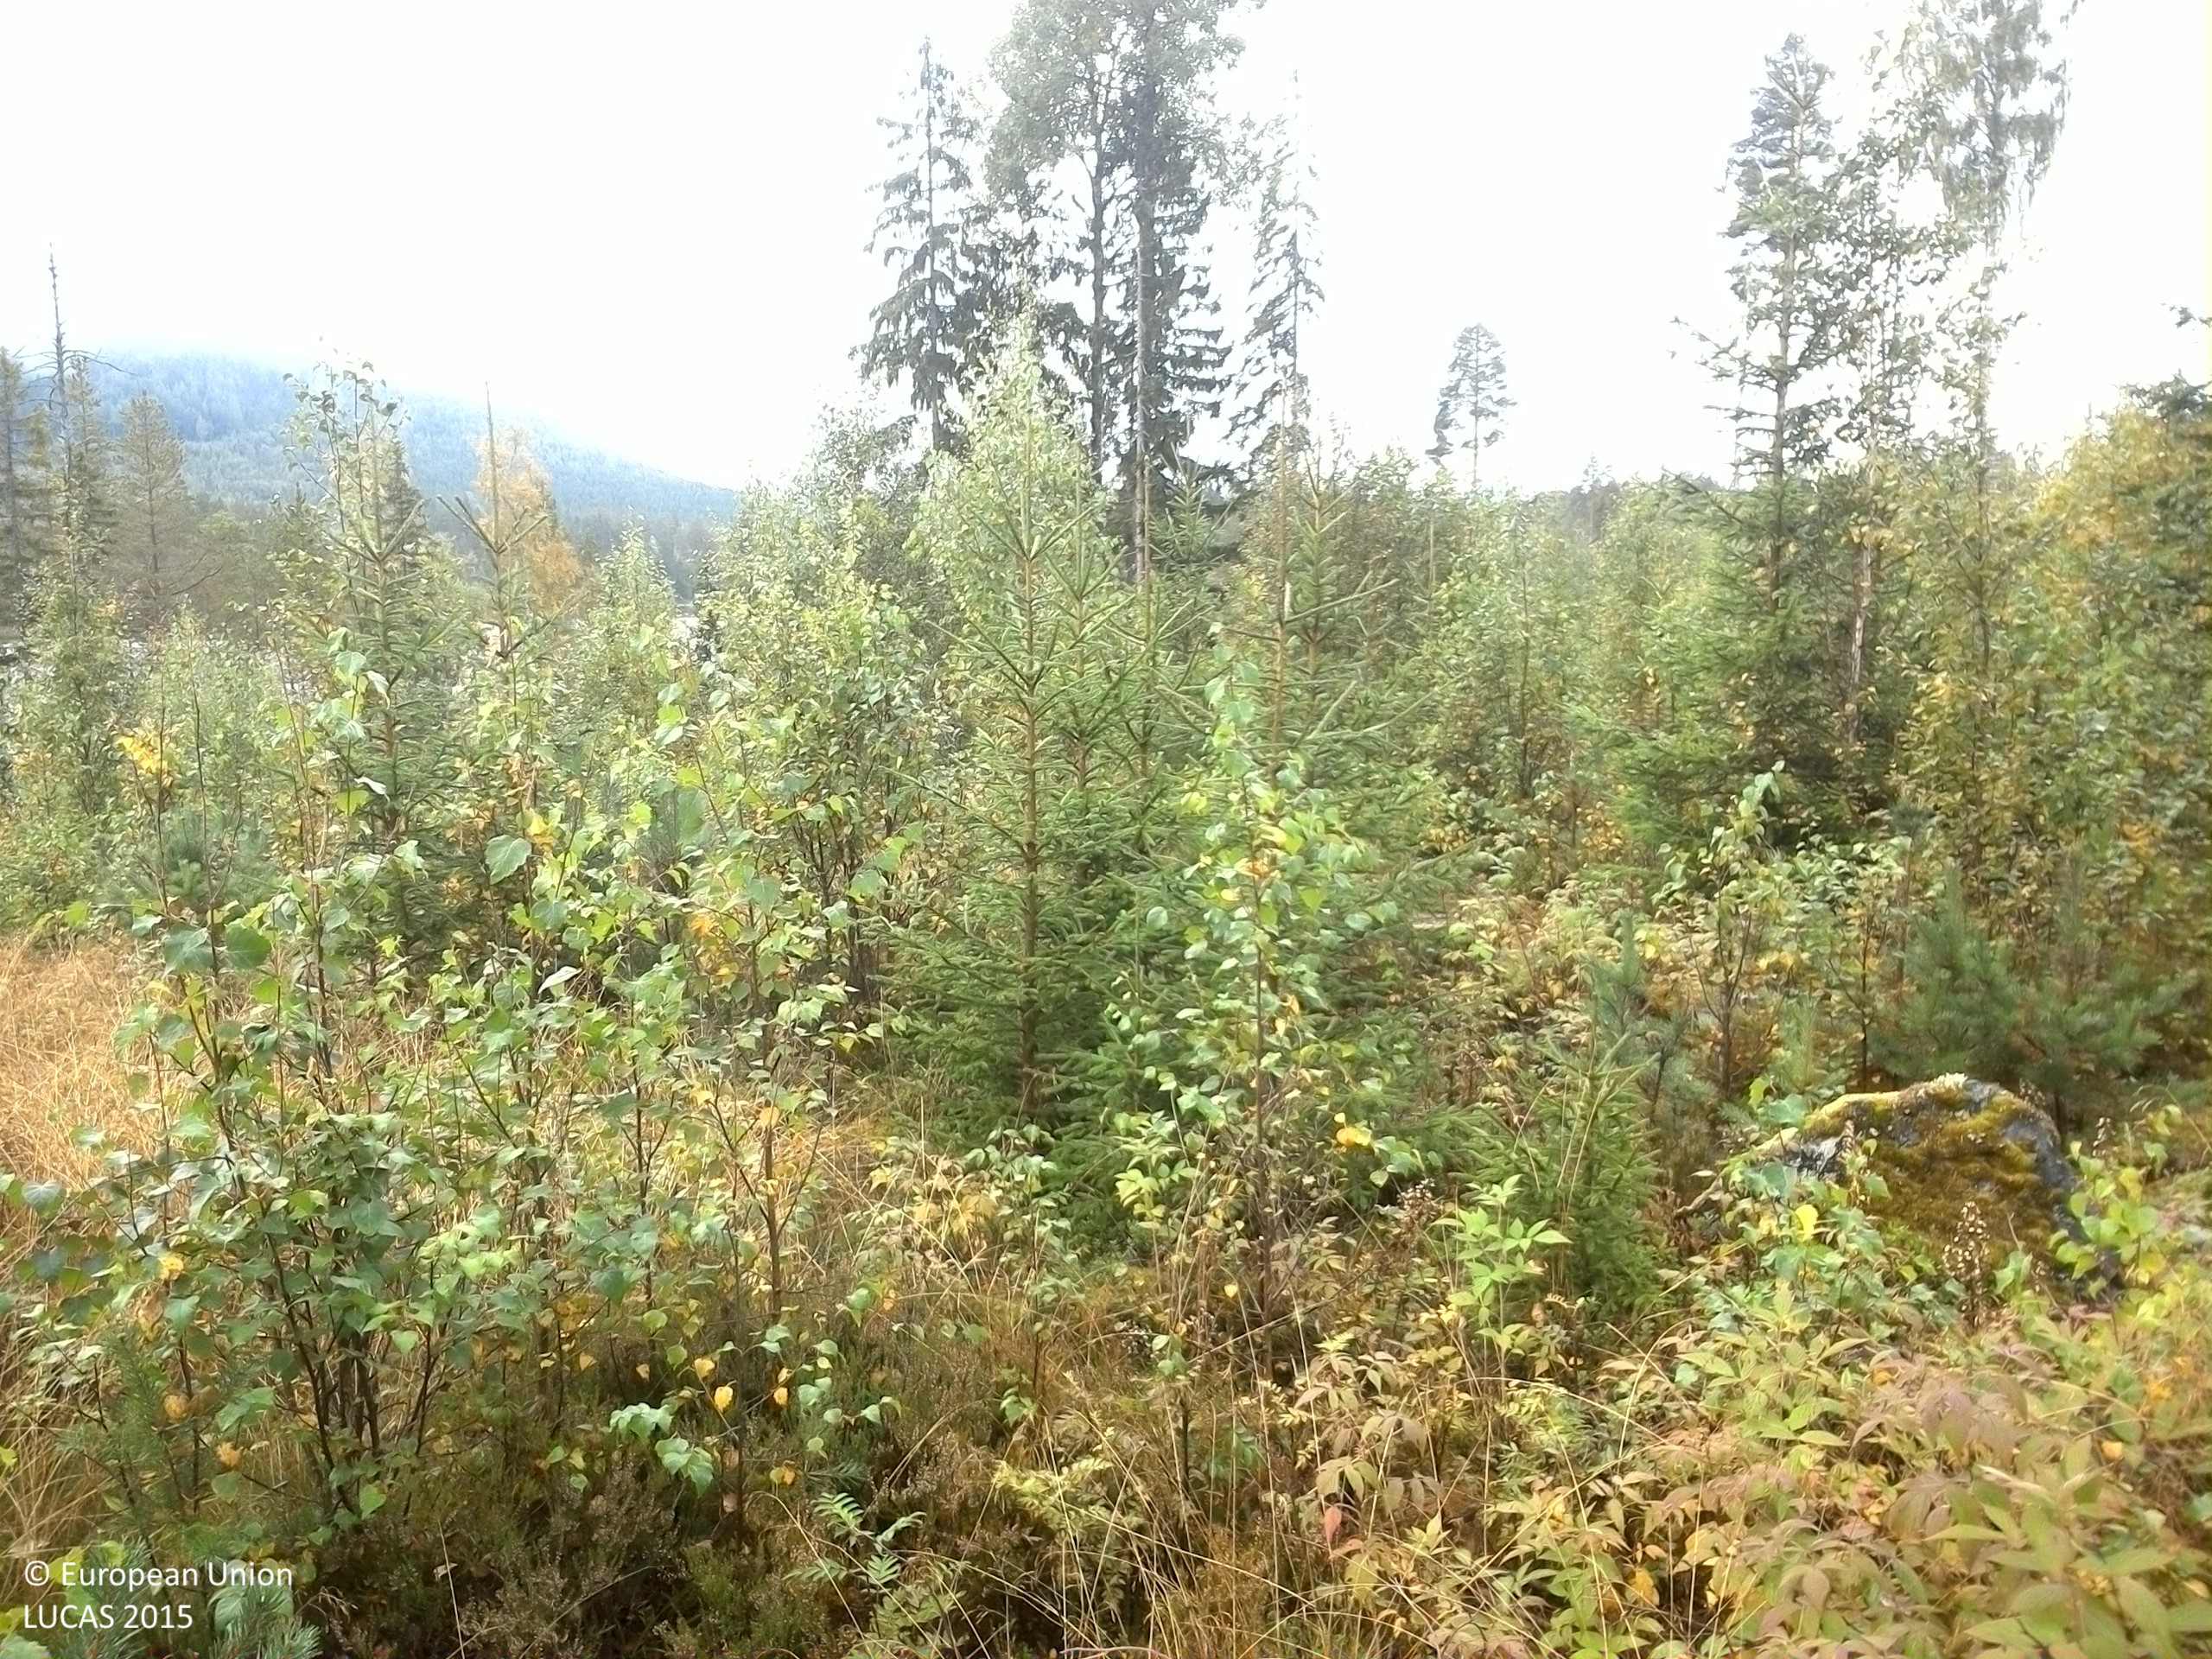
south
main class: Woodland
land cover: Other mixed woodland
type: boreal forest
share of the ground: 50 - 75 %
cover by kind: coniferous forest trees 30 %, broadleaved forest trees 30 %, shrubs 20 %, herbaceous plants 10 %, lichens and mosses 10 %
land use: Forestry
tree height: < 5 m
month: September
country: SE
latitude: 61.6383
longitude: 15.1730
